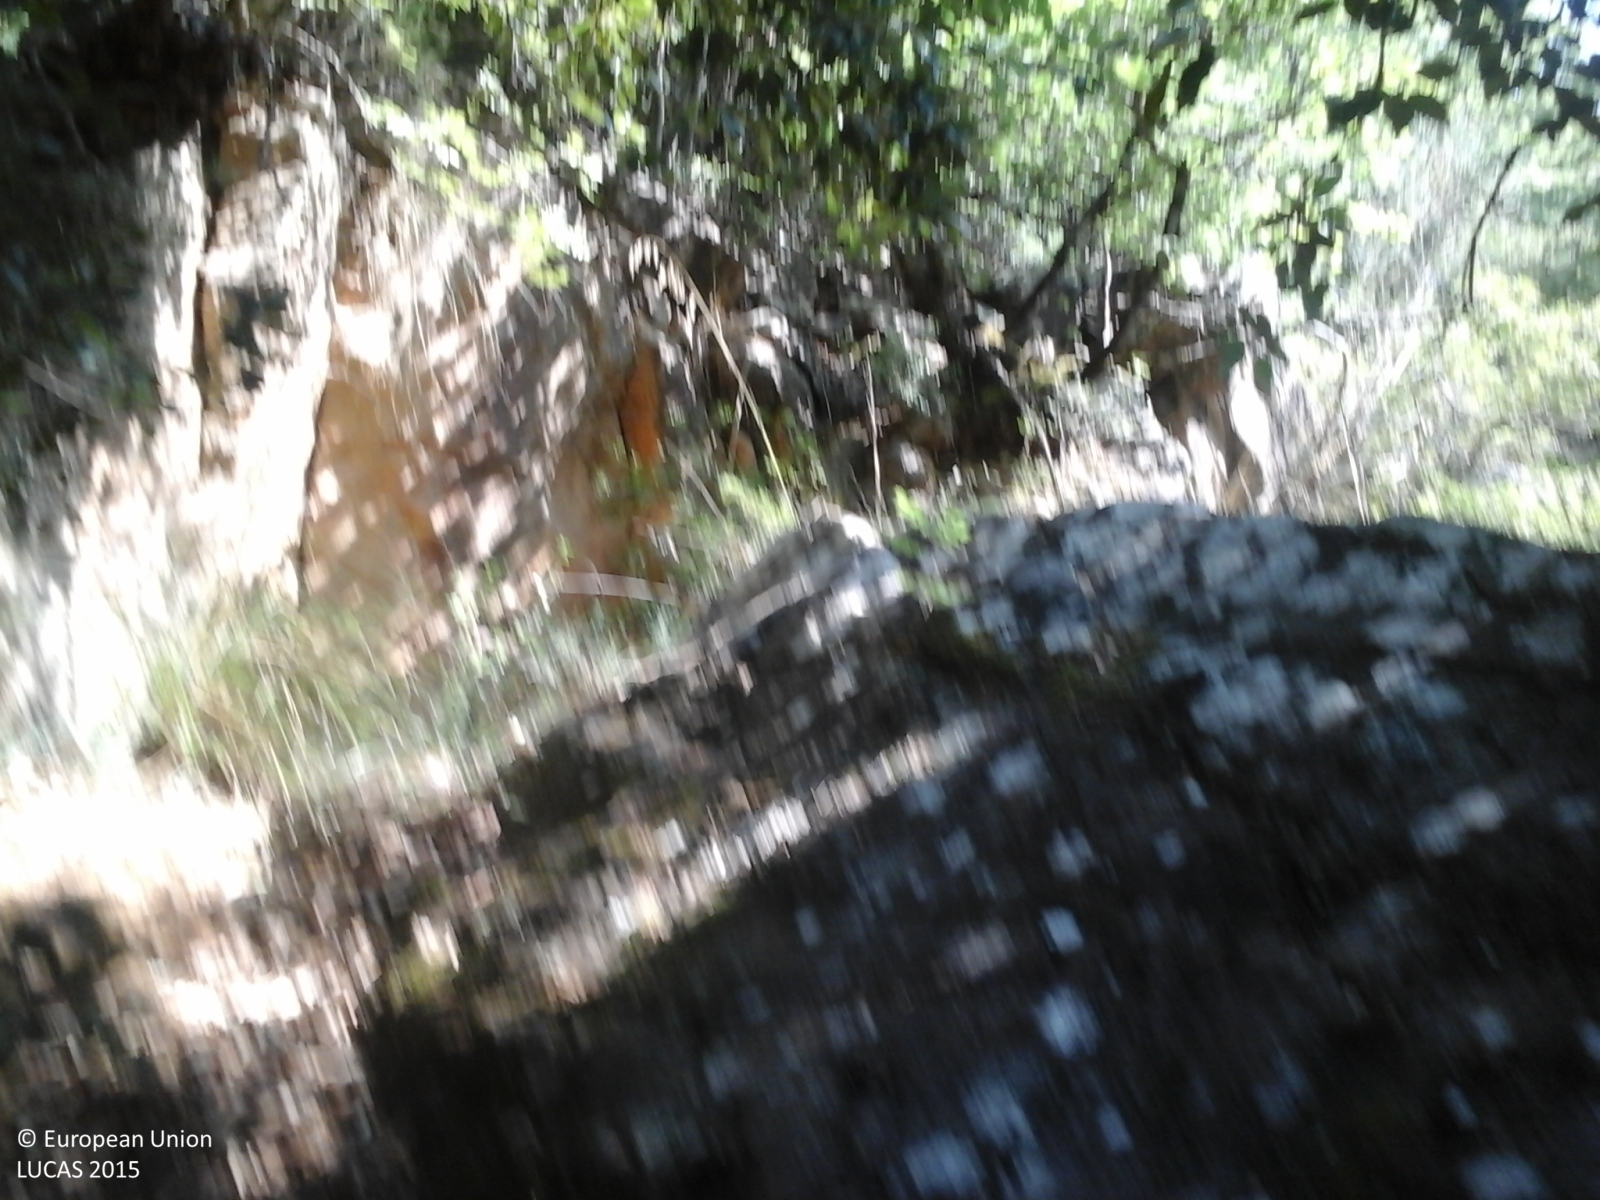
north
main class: Woodland
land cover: Broadleaved woodland
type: thermophilous deciduous forest
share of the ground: > 75 %
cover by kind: broadleaved forest trees 45 %, shrubs 30 %, herbaceous plants 25 %
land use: Semi-natural and natural areas not in use
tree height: < 5 m
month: July
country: IT
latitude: 42.9311
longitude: 11.5513
